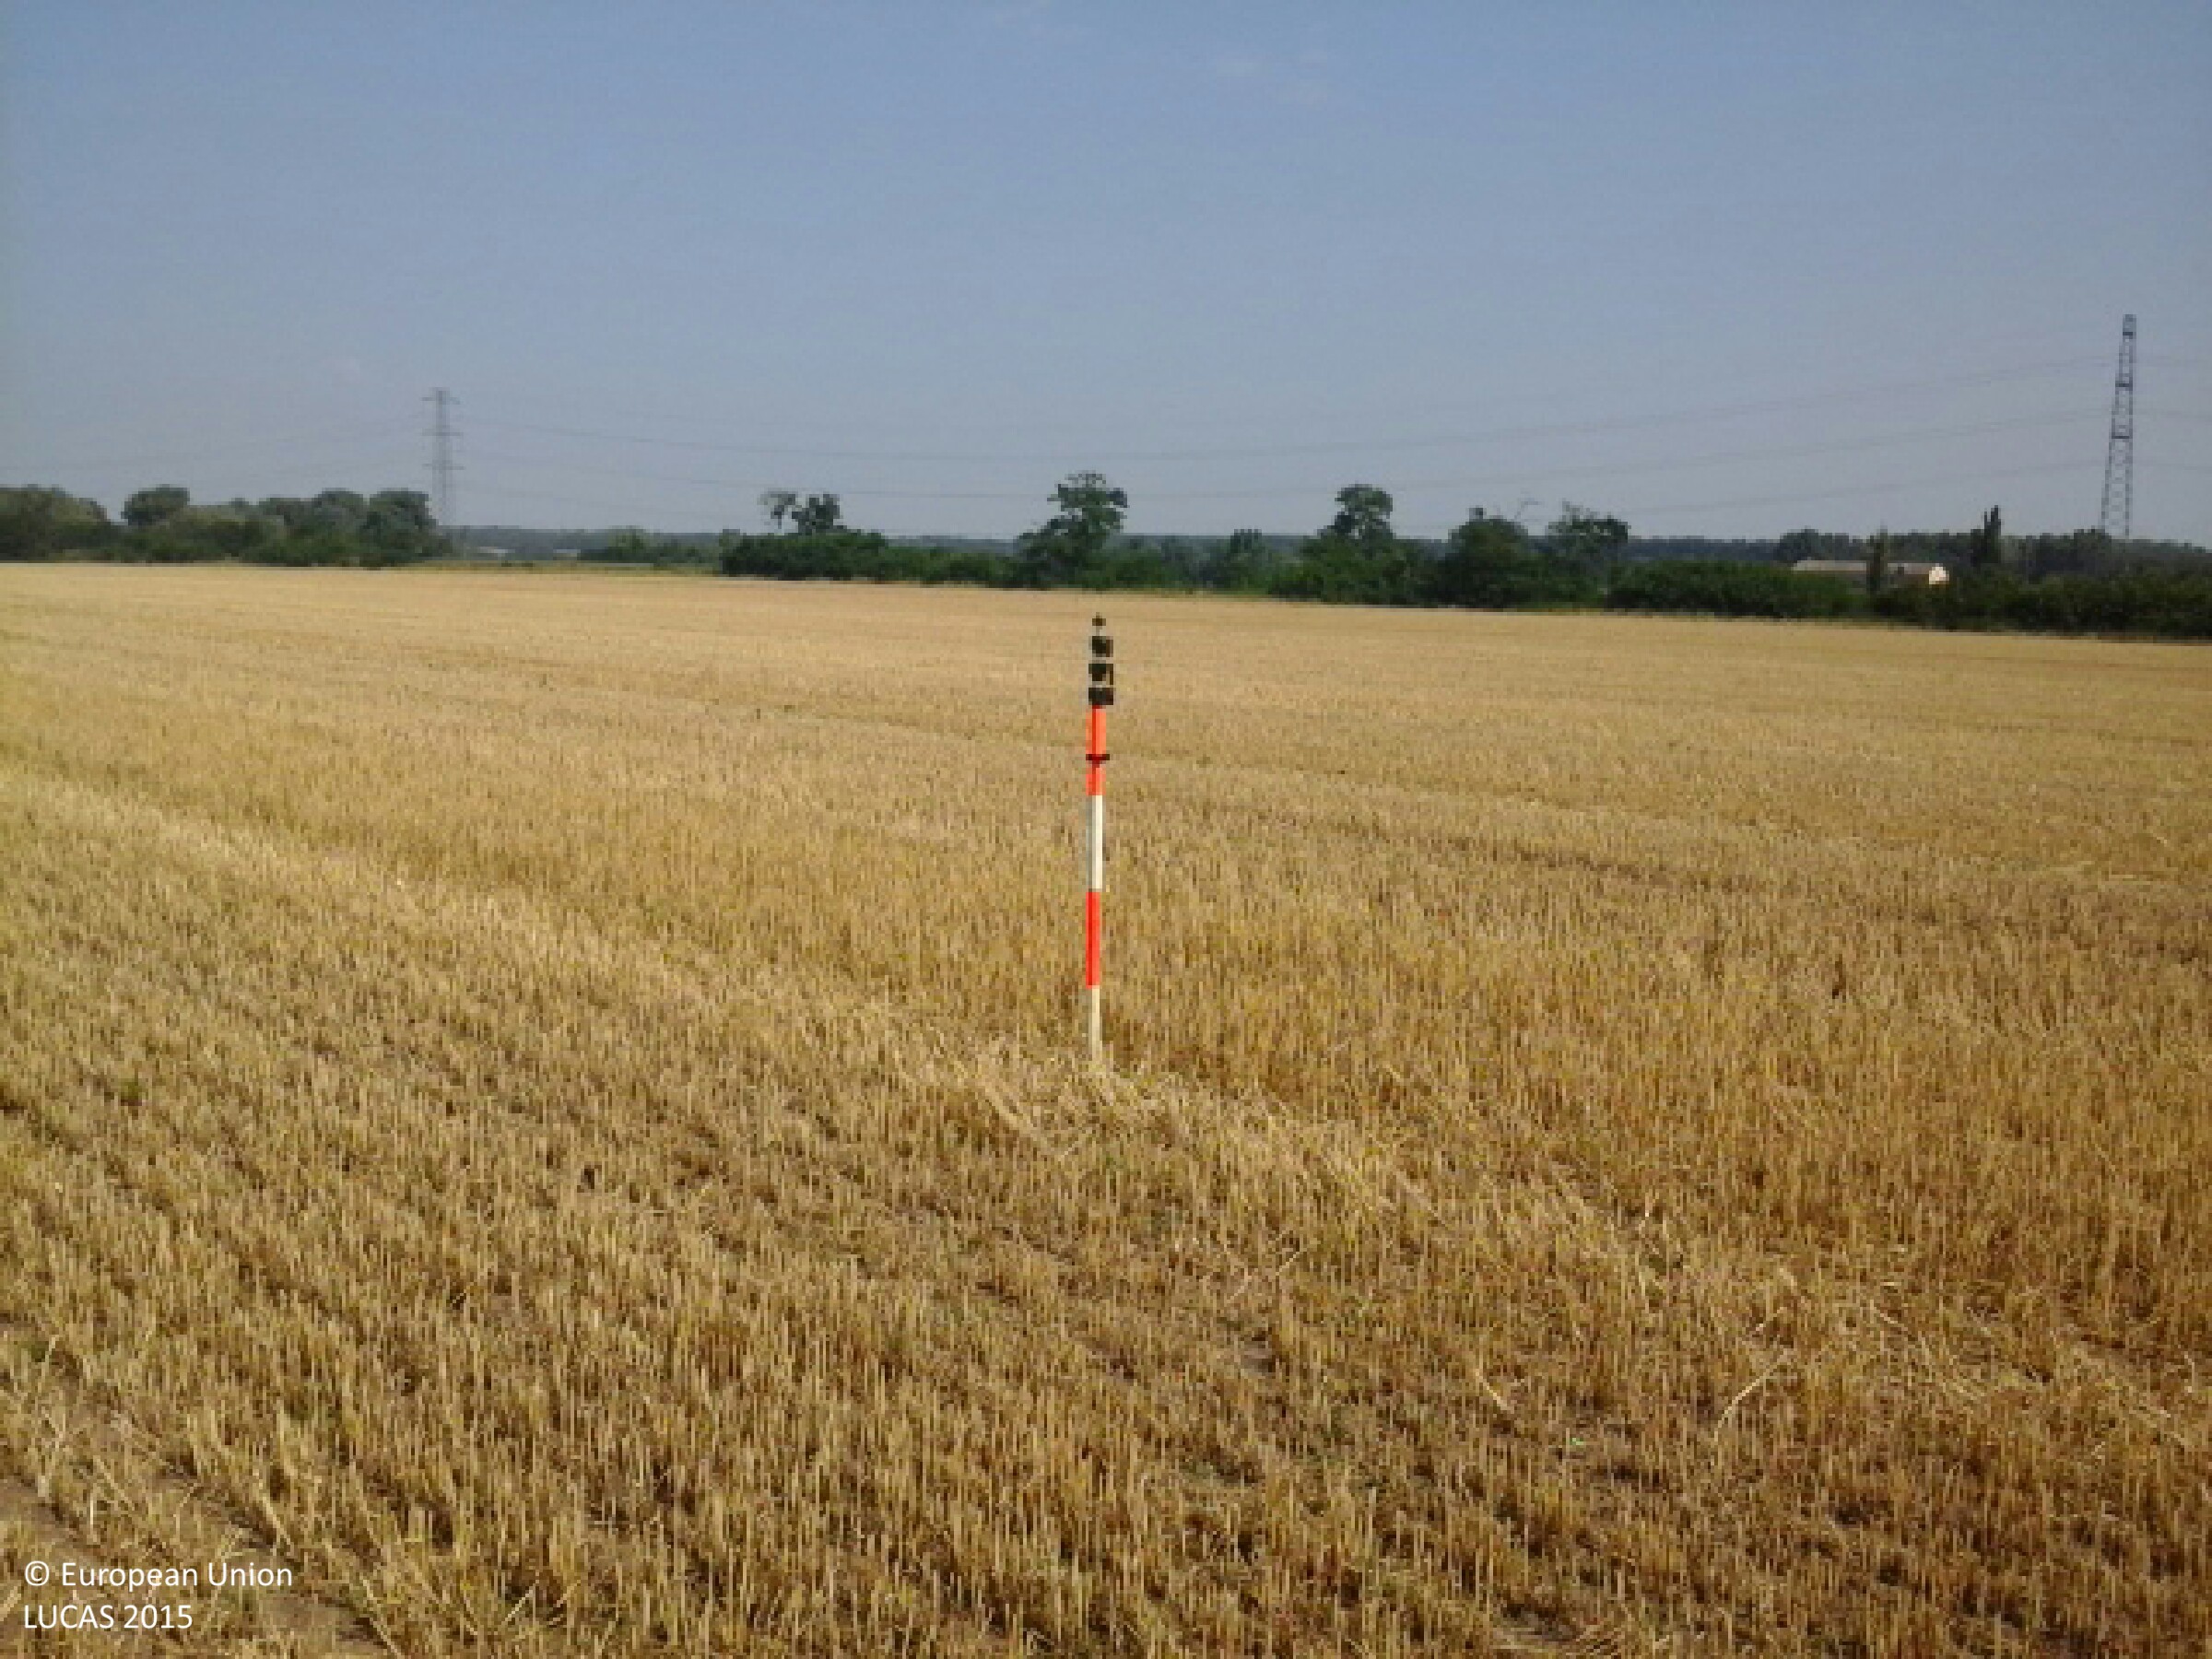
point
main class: Cropland
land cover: Triticale
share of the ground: 10 - 25 %
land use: Agriculture (excluding fallow land and kitchen gardens)
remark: Harvested field
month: August
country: HU
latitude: 47.5451
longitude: 18.1030
